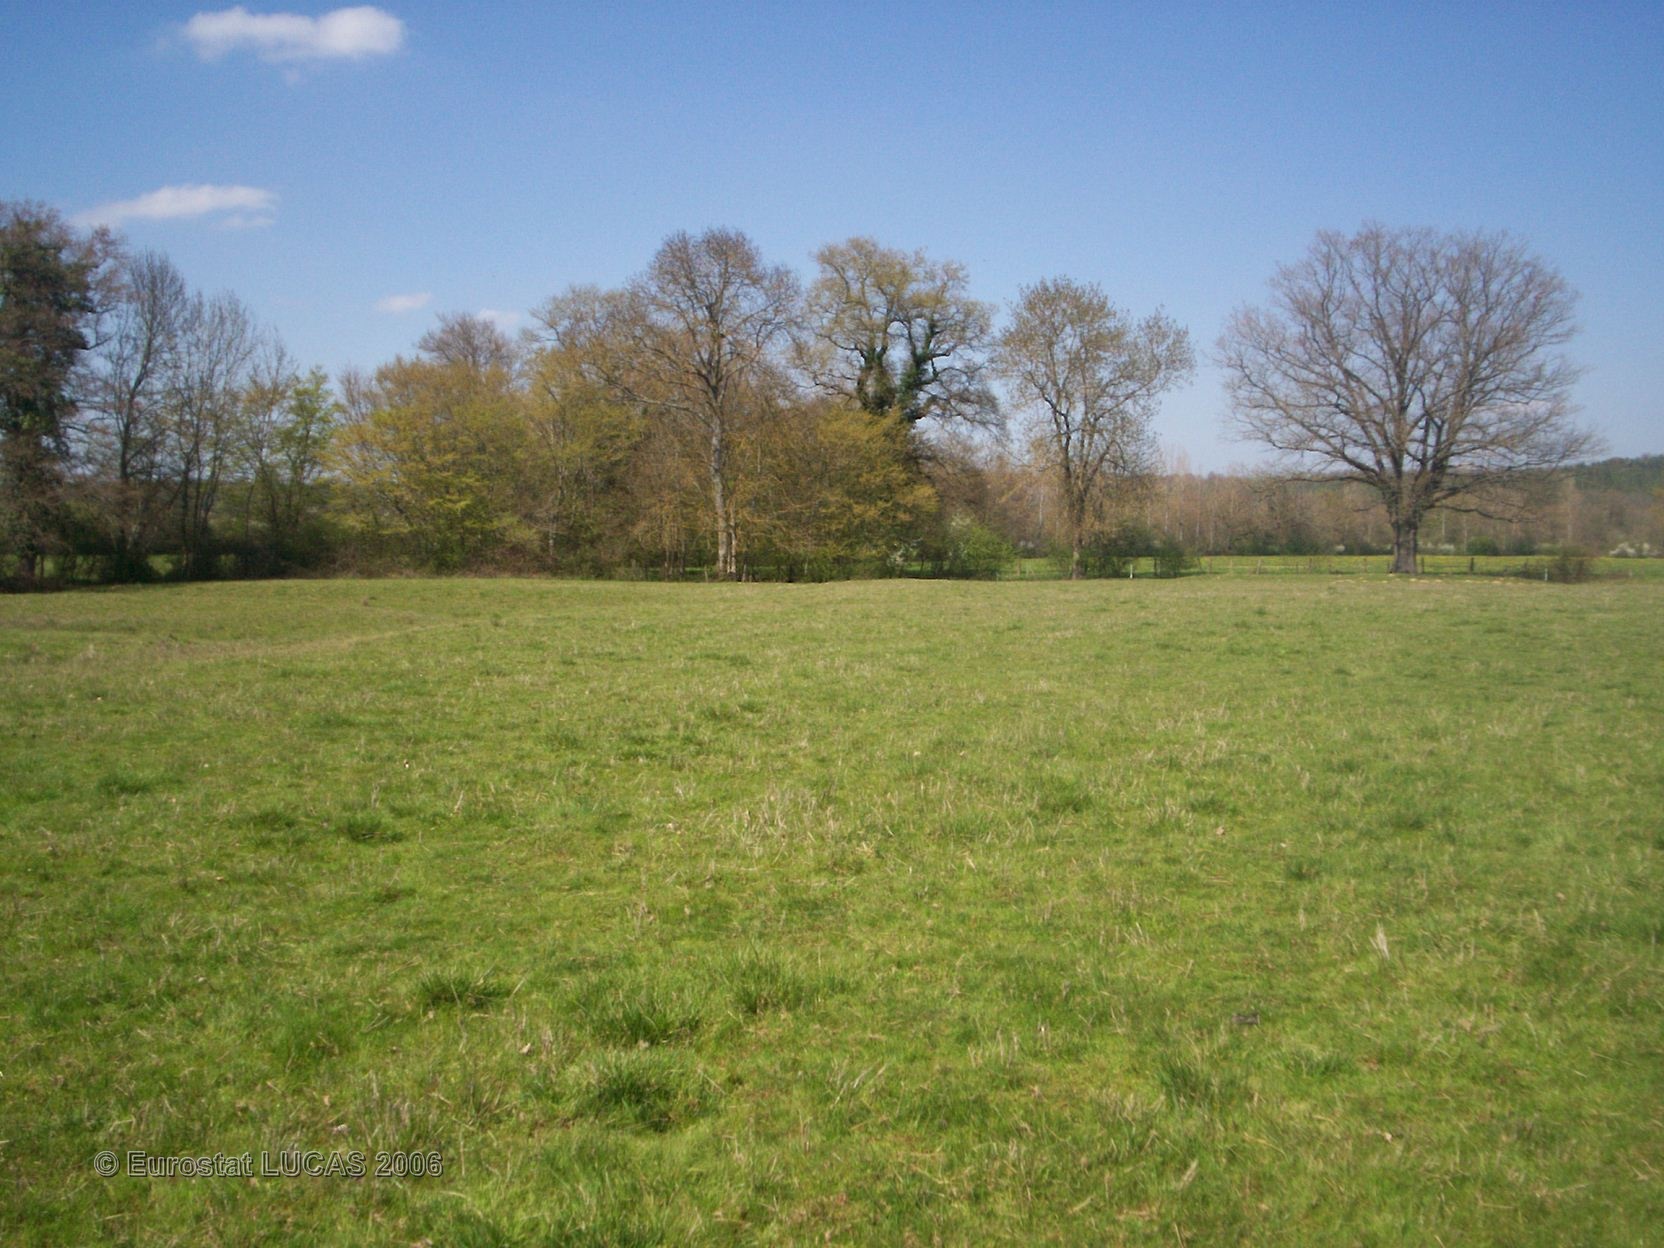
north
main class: Grassland
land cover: Grassland without tree/shrub cover
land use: Agriculture (excluding fallow land and kitchen gardens)
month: April
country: FR
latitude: 46.6548
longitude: 3.1368
